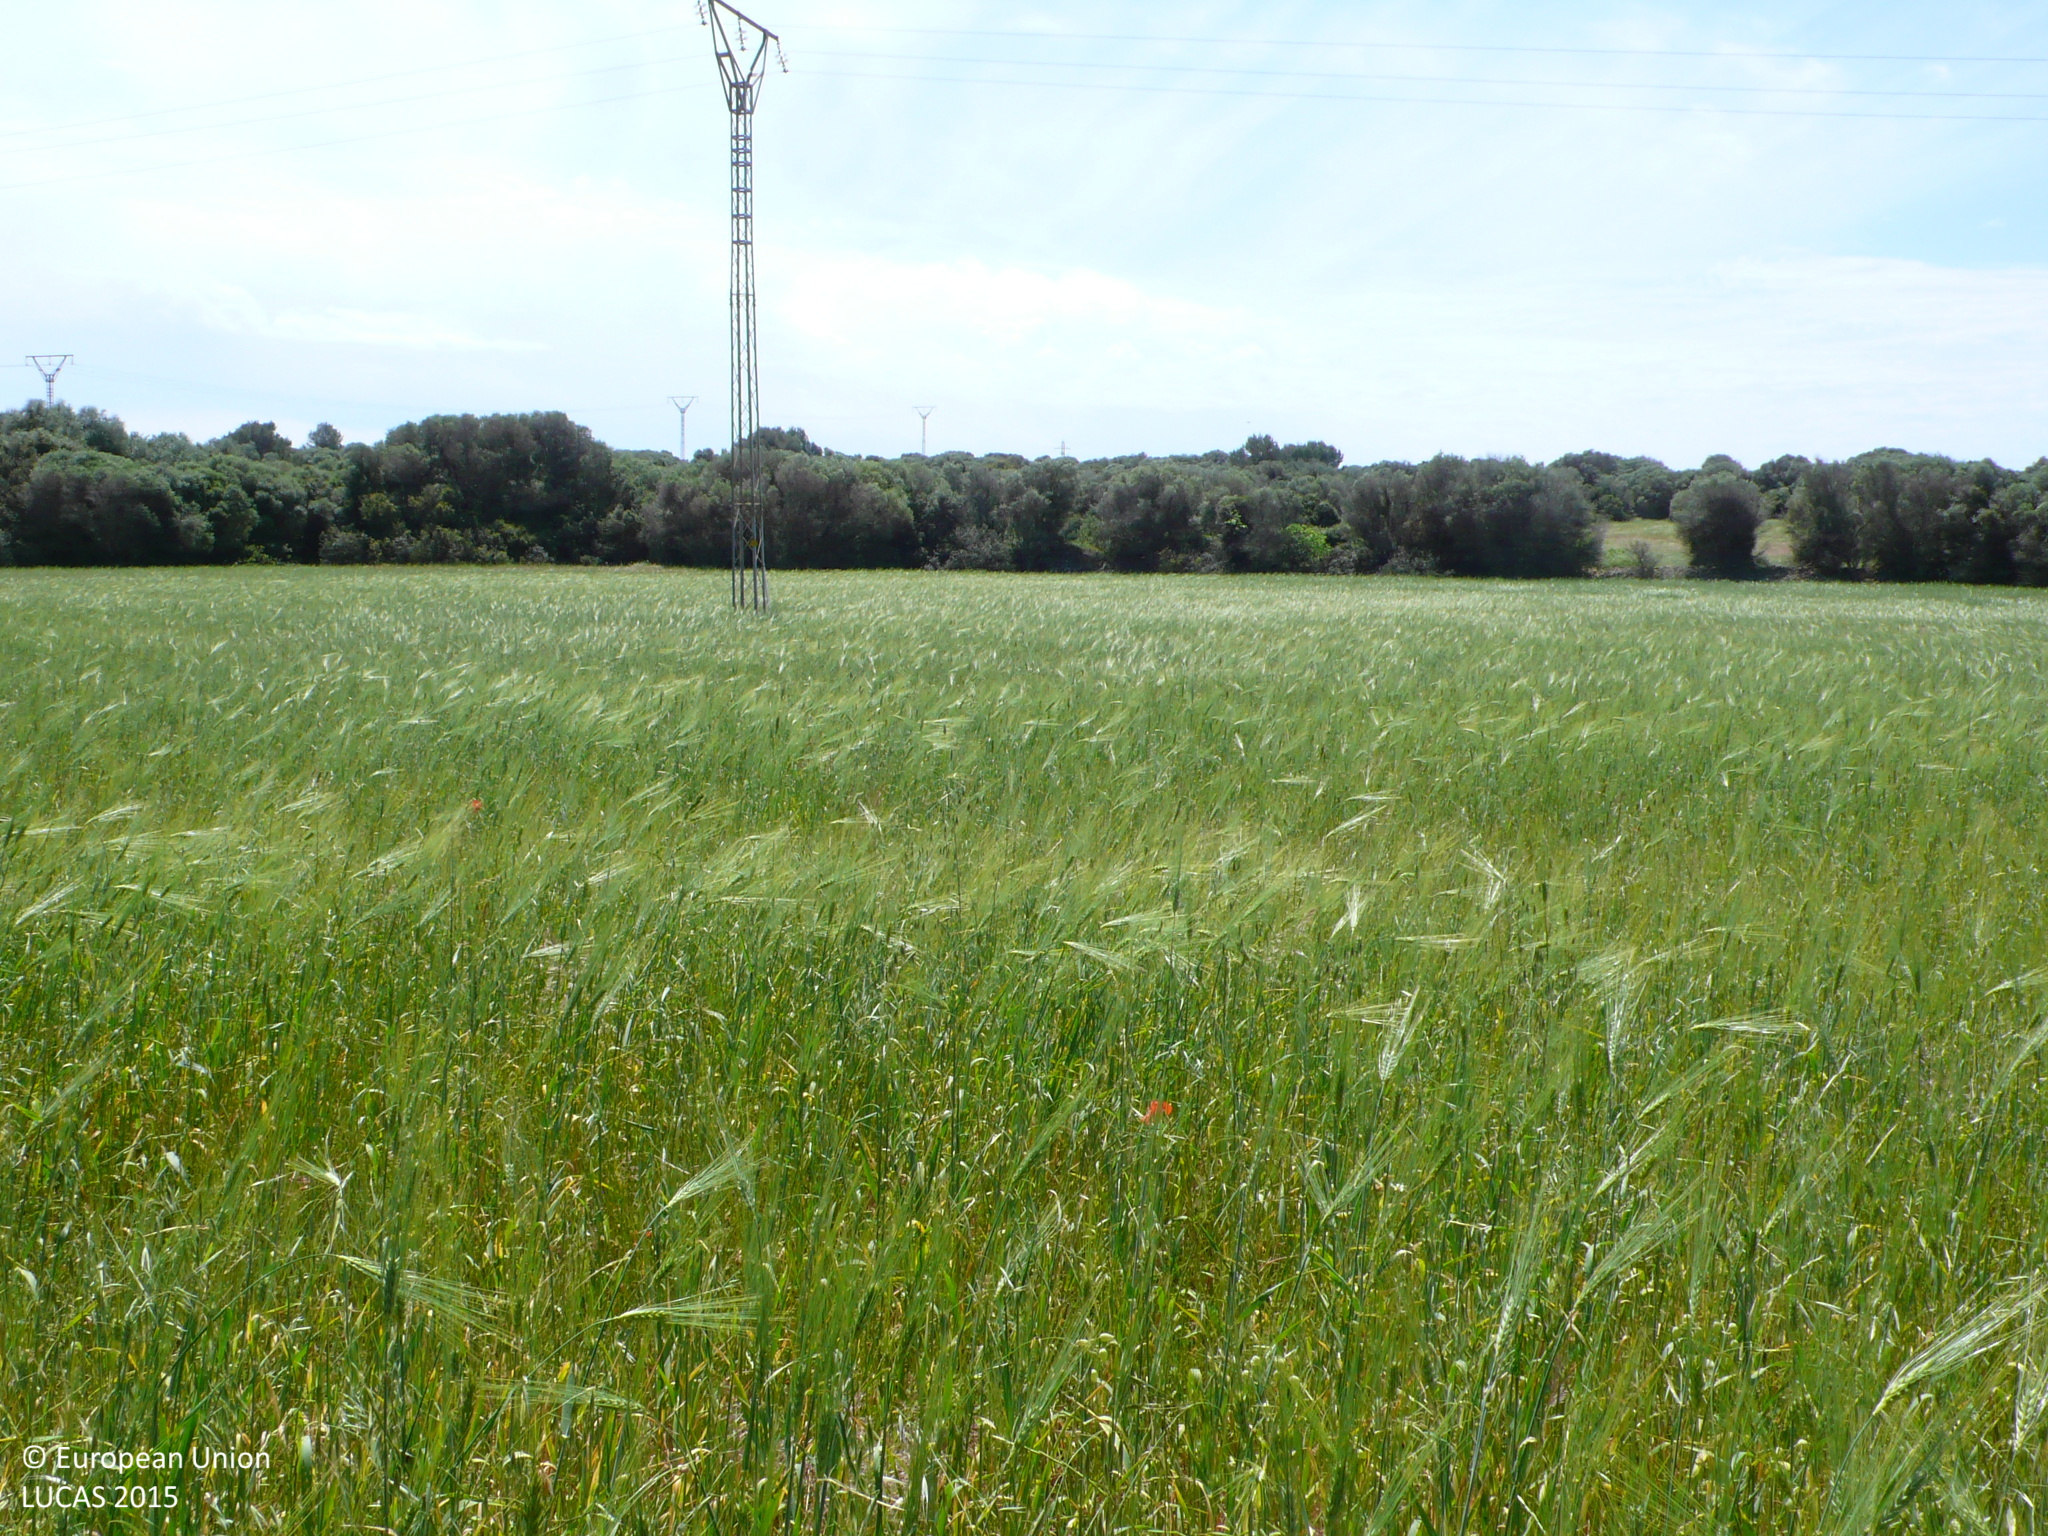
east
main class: Woodland
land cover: Broadleaved woodland
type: broadleaved evergreen forest
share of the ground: 50 - 75 %
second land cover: Grassland without tree/shrub cover
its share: 50 - 75 %
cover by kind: broadleaved forest trees 55 %, herbaceous plants 35 %, shrubs 10 %
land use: Forestry
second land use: Agriculture (excluding fallow land and kitchen gardens)
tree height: > 5 m
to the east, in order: Broadleaved woodland; Grassland without tree/shrub cover; Dry stone walls; Broadleaved woodland; Shrubland with sparse tree cover; Dry stone walls; Shrubland with sparse tree cover; Dry stone walls; Shrubland with sparse tree cover; Electric lines; Shrubland with sparse tree cover; Grassland with sparse tree/shrub cover; Broadleaved woodland; Dry stone walls; Broadleaved woodland; Dry stone walls; Tracks; Fences; Broadleaved woodland
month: May
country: ES
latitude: 39.9232
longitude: 4.0476
